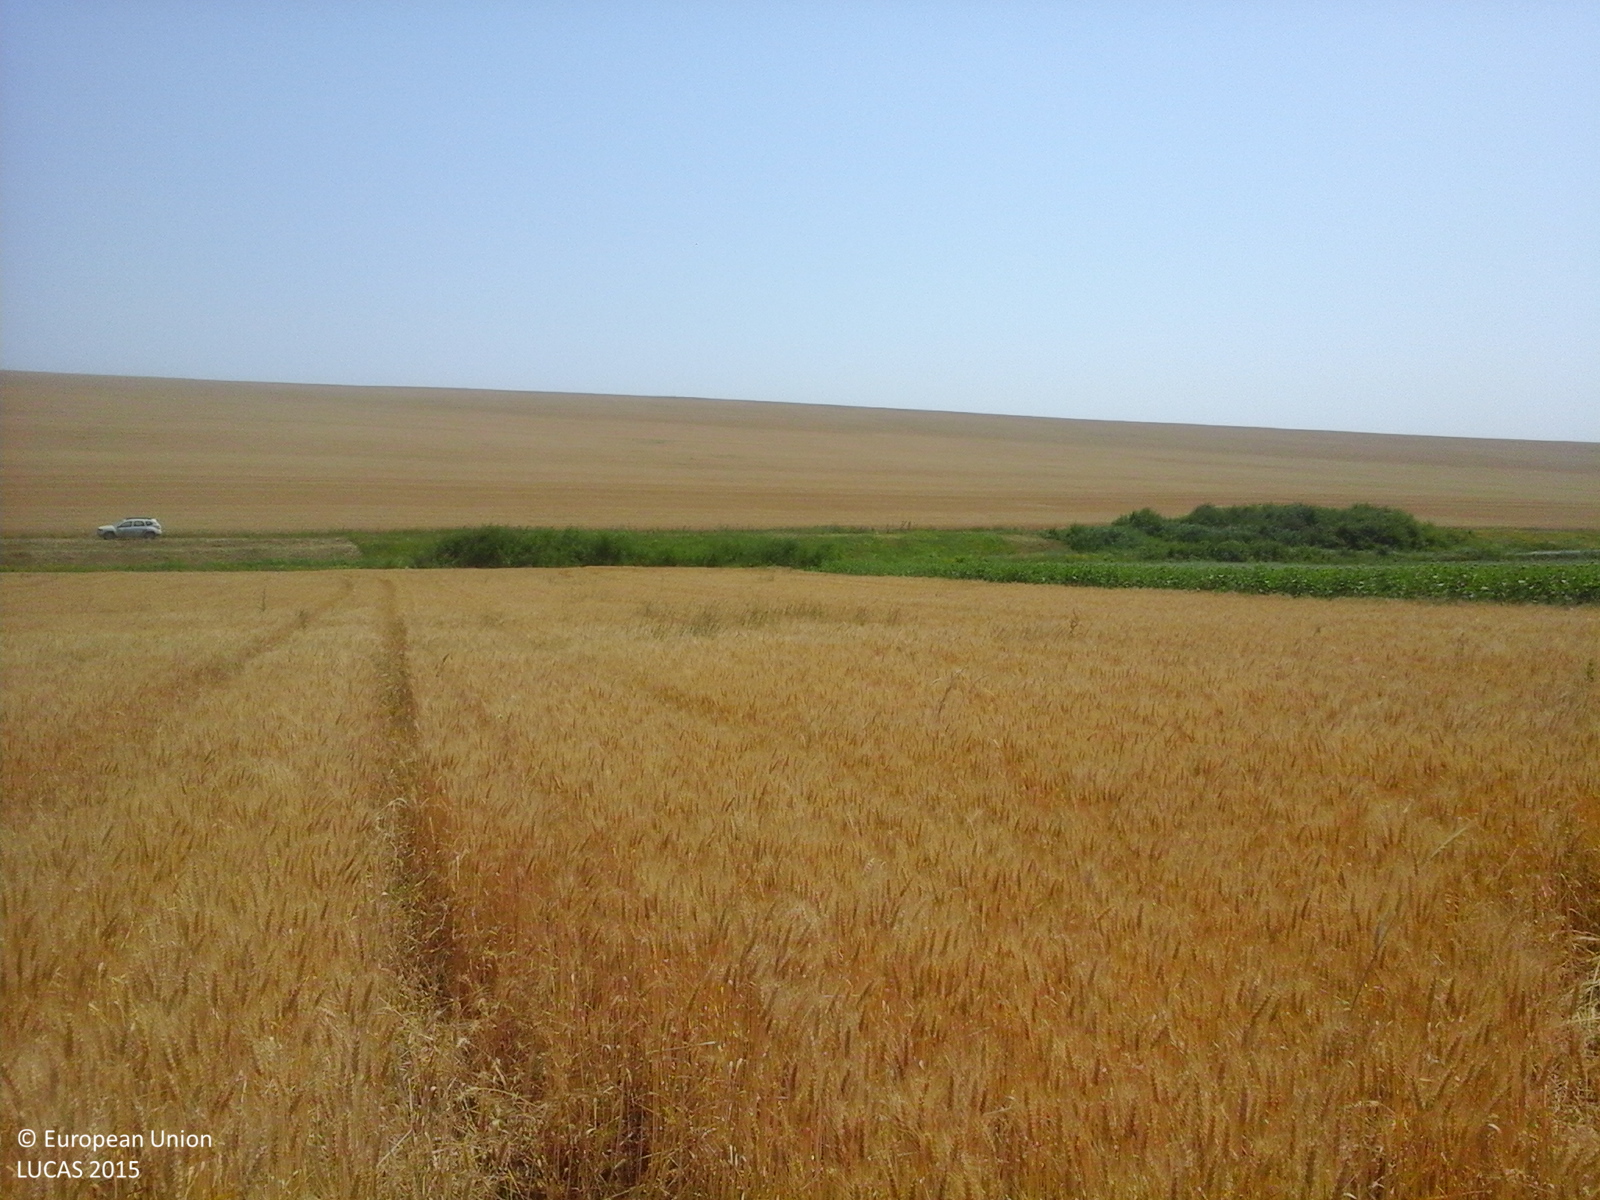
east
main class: Cropland
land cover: Common wheat
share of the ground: > 75 %
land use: Agriculture (excluding fallow land and kitchen gardens)
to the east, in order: Common wheat; Abandoned hedges; Spontaneously vegetated surfaces; Inland fresh running water; Spontaneously vegetated surfaces; Tracks; Common wheat
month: June
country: RO
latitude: 46.8769
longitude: 27.3096
